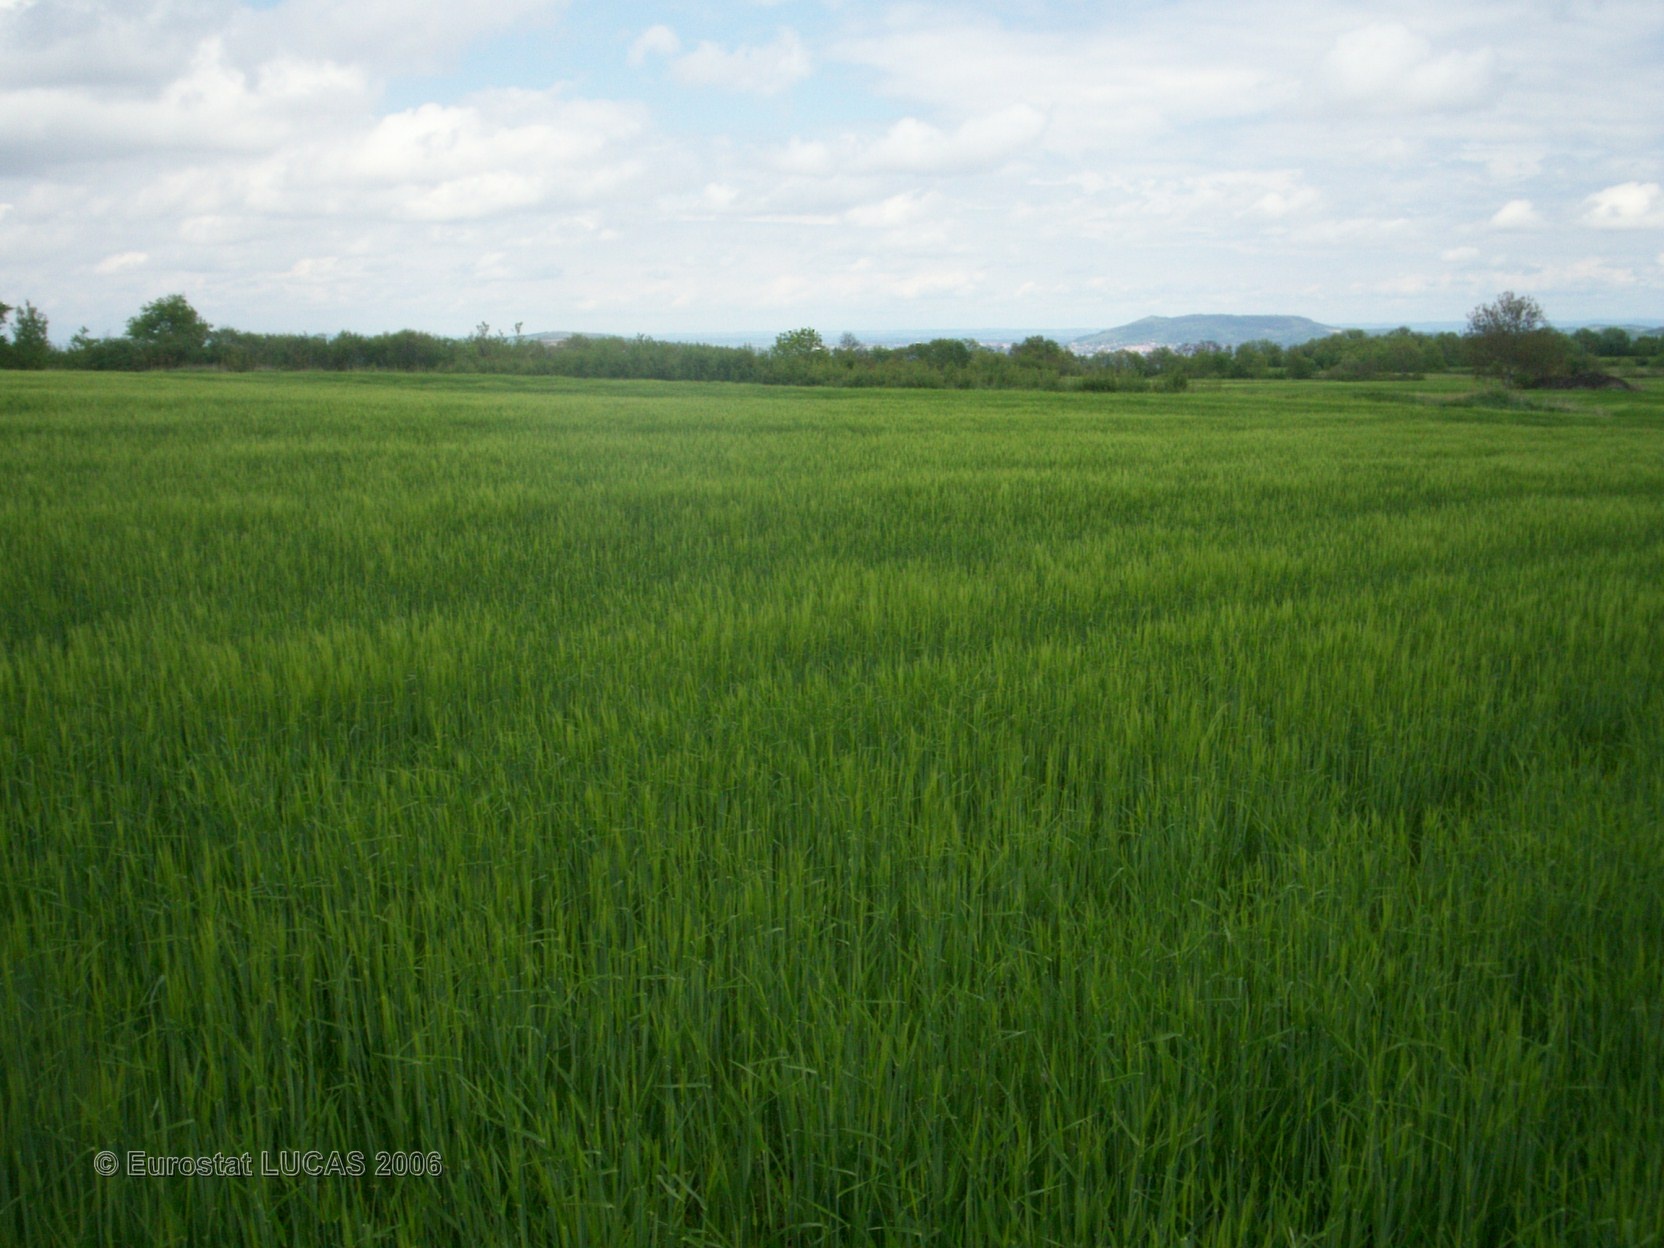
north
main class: Cropland
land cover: Barley
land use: Agriculture (excluding fallow land and kitchen gardens)
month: May
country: FR
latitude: 45.6638
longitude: 3.1850
